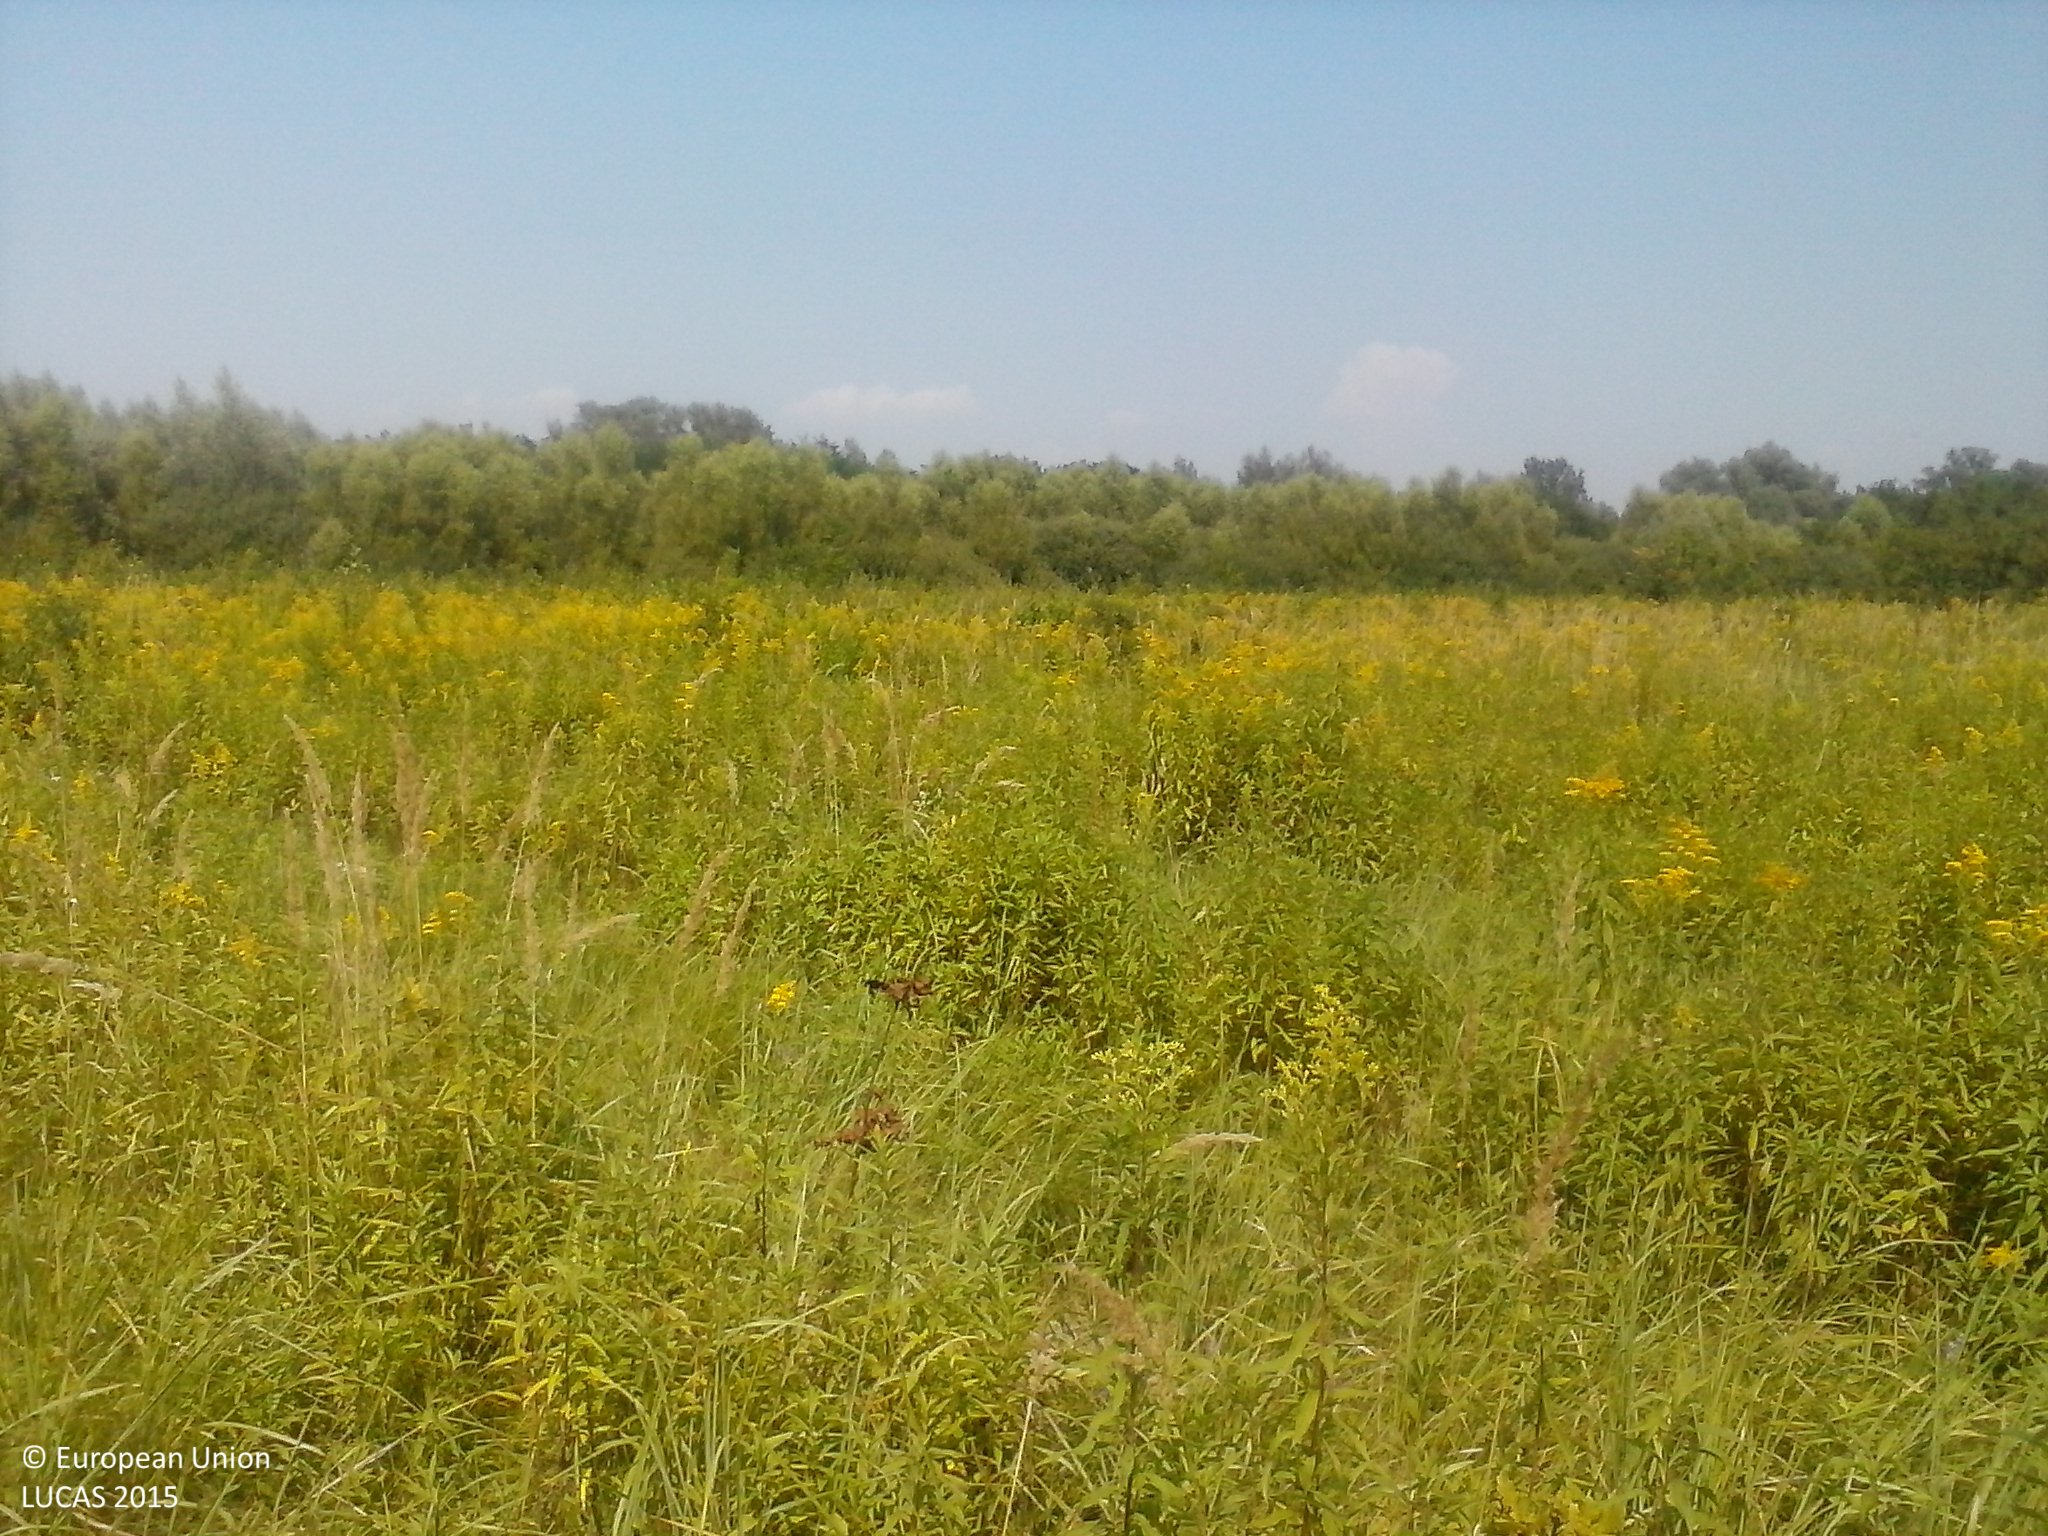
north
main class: Woodland
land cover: Broadleaved woodland
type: acidophilous oak and oak-birch forest
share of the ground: 10 - 25 %
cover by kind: herbaceous plants 80 %, broadleaved forest trees 10 %, shrubs 10 %
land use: Forestry
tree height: < 5 m
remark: Nursery
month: August
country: HU
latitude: 45.8021
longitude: 17.9433
